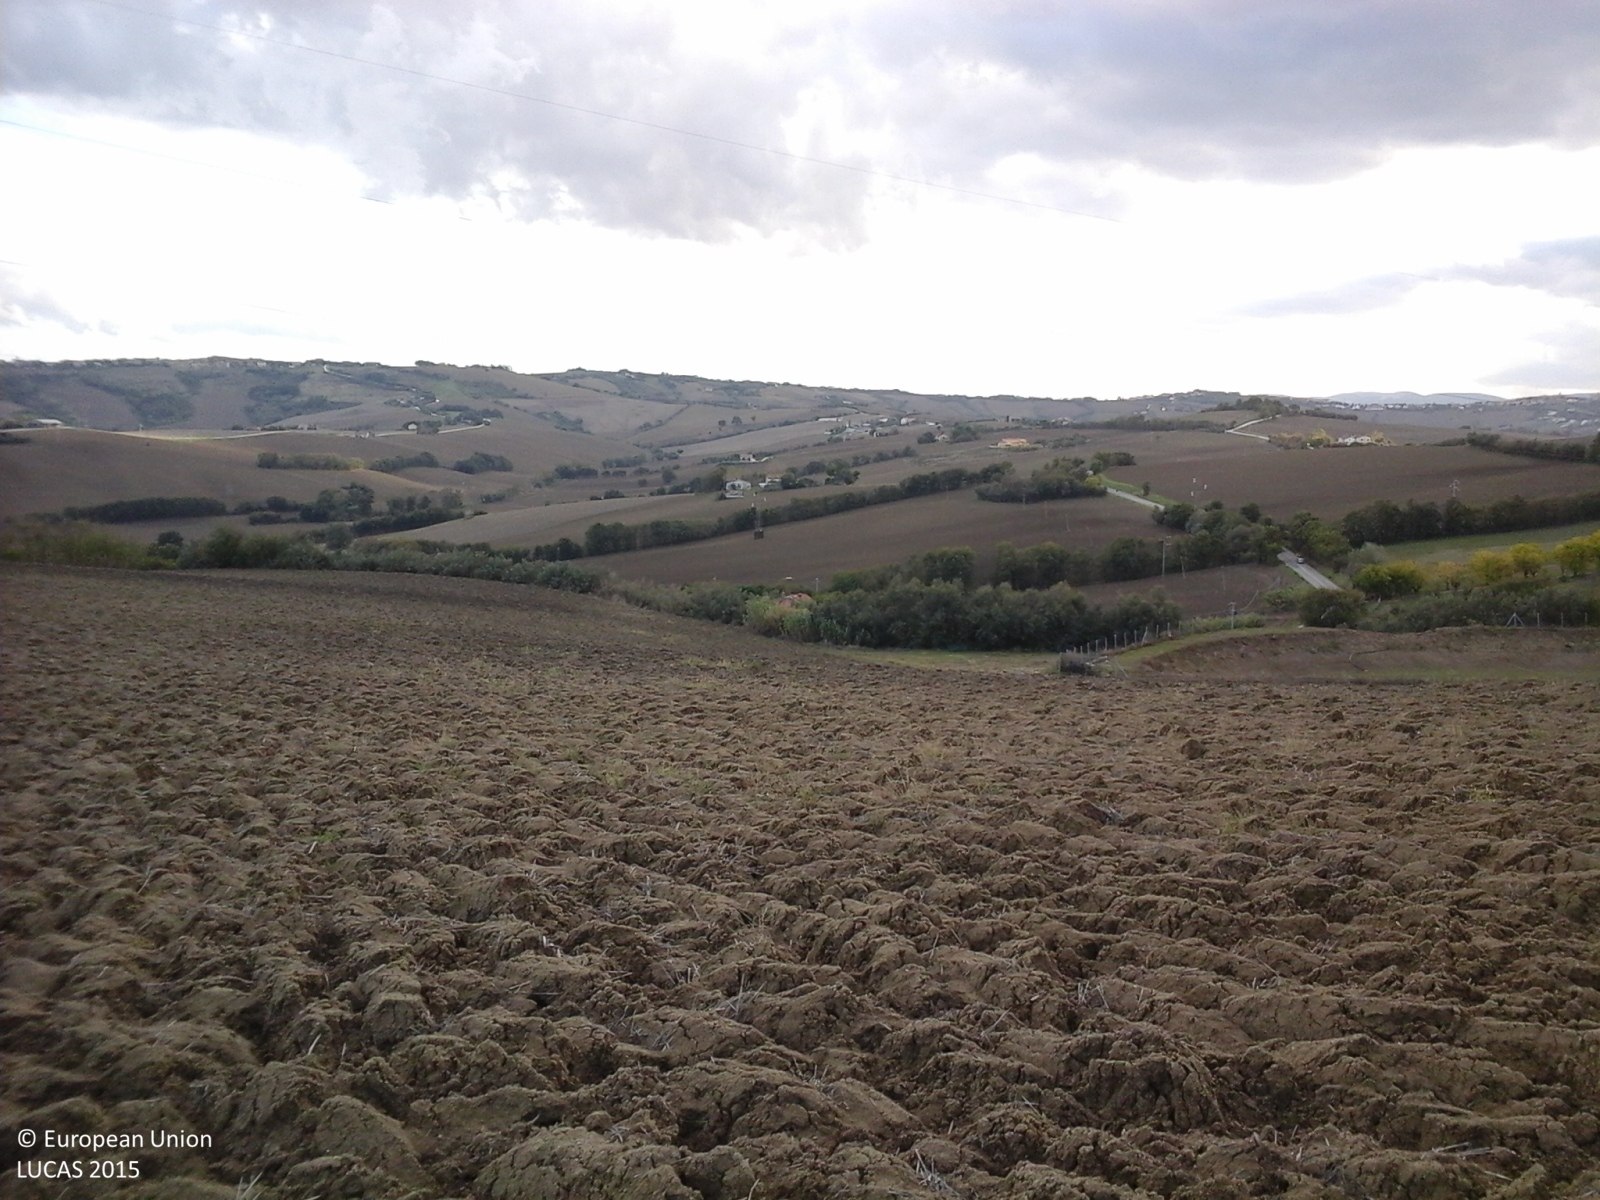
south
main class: Cropland
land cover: Durum wheat
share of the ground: < 10 %
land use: Agriculture (excluding fallow land and kitchen gardens)
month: October
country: IT
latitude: 43.5383
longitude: 13.3456
